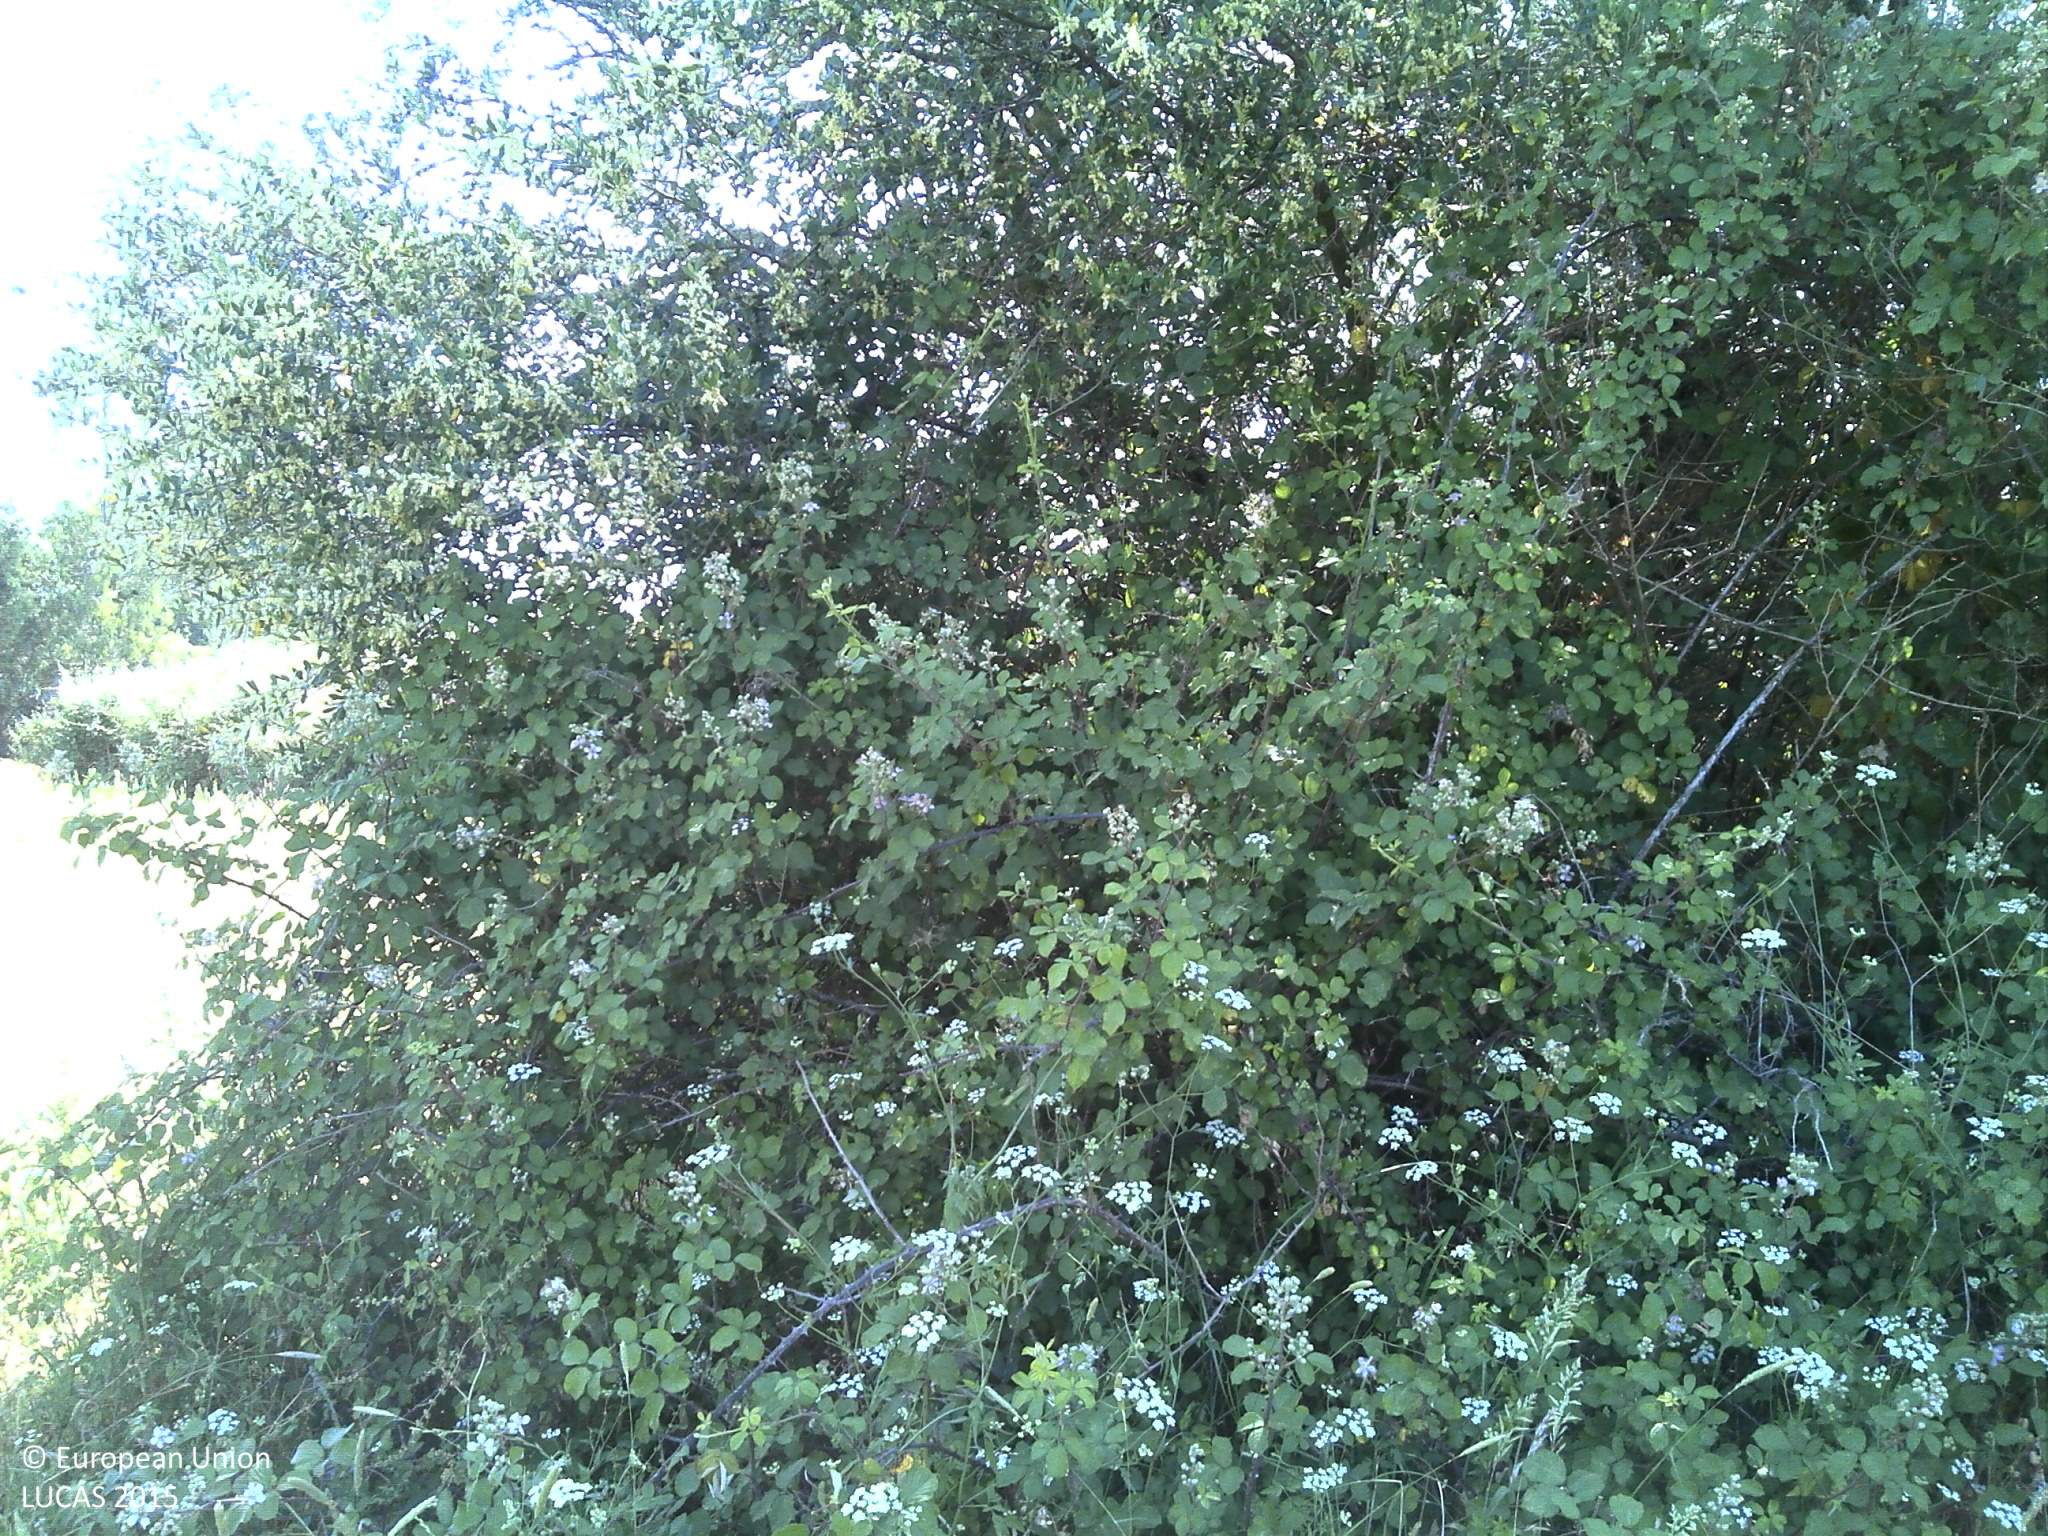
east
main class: Grassland
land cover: Grassland with sparse tree/shrub cover
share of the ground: > 75 %
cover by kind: herbaceous plants 90 %, broadleaved forest trees 5 %, unconsolidated bare surface 5 %
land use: Agriculture (excluding fallow land and kitchen gardens)
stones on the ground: < 10 %
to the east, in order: Grassland with sparse tree/shrub cover; Abandoned hedges; Rivers and streams; Abandoned hedges; Spontaneously vegetated surfaces; Shrubland with sparse tree cover; Fences; Grass margins; Paved roads, cycling and walking lanes; Grass margins; Broadleaved woodland; Fences; Spontaneously vegetated surfaces
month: June
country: PT
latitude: 38.6865
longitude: -8.0599
